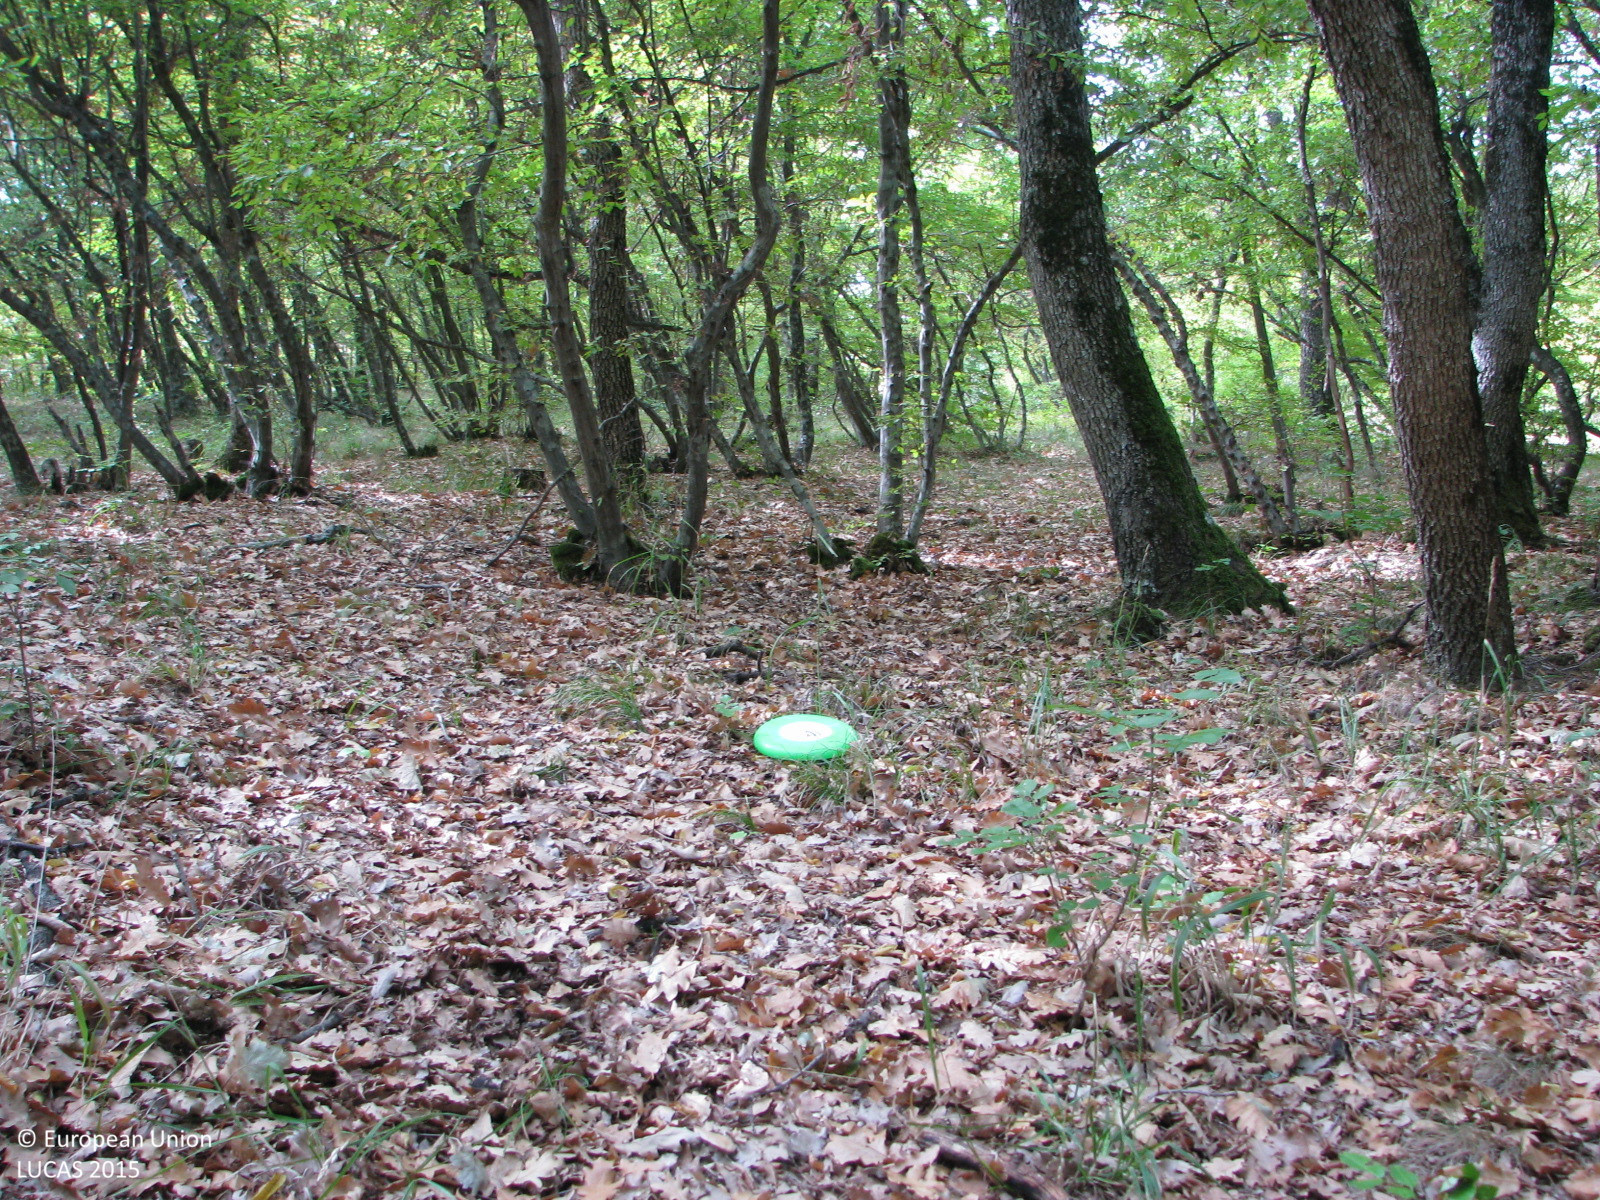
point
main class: Woodland
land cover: Broadleaved woodland
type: mesophytic deciduous forest
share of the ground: 50 - 75 %
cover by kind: broadleaved forest trees 70 %, unconsolidated bare surface 30 %
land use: Forestry
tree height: > 5 m
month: October
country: BG
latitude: 42.5425
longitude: 25.9216
